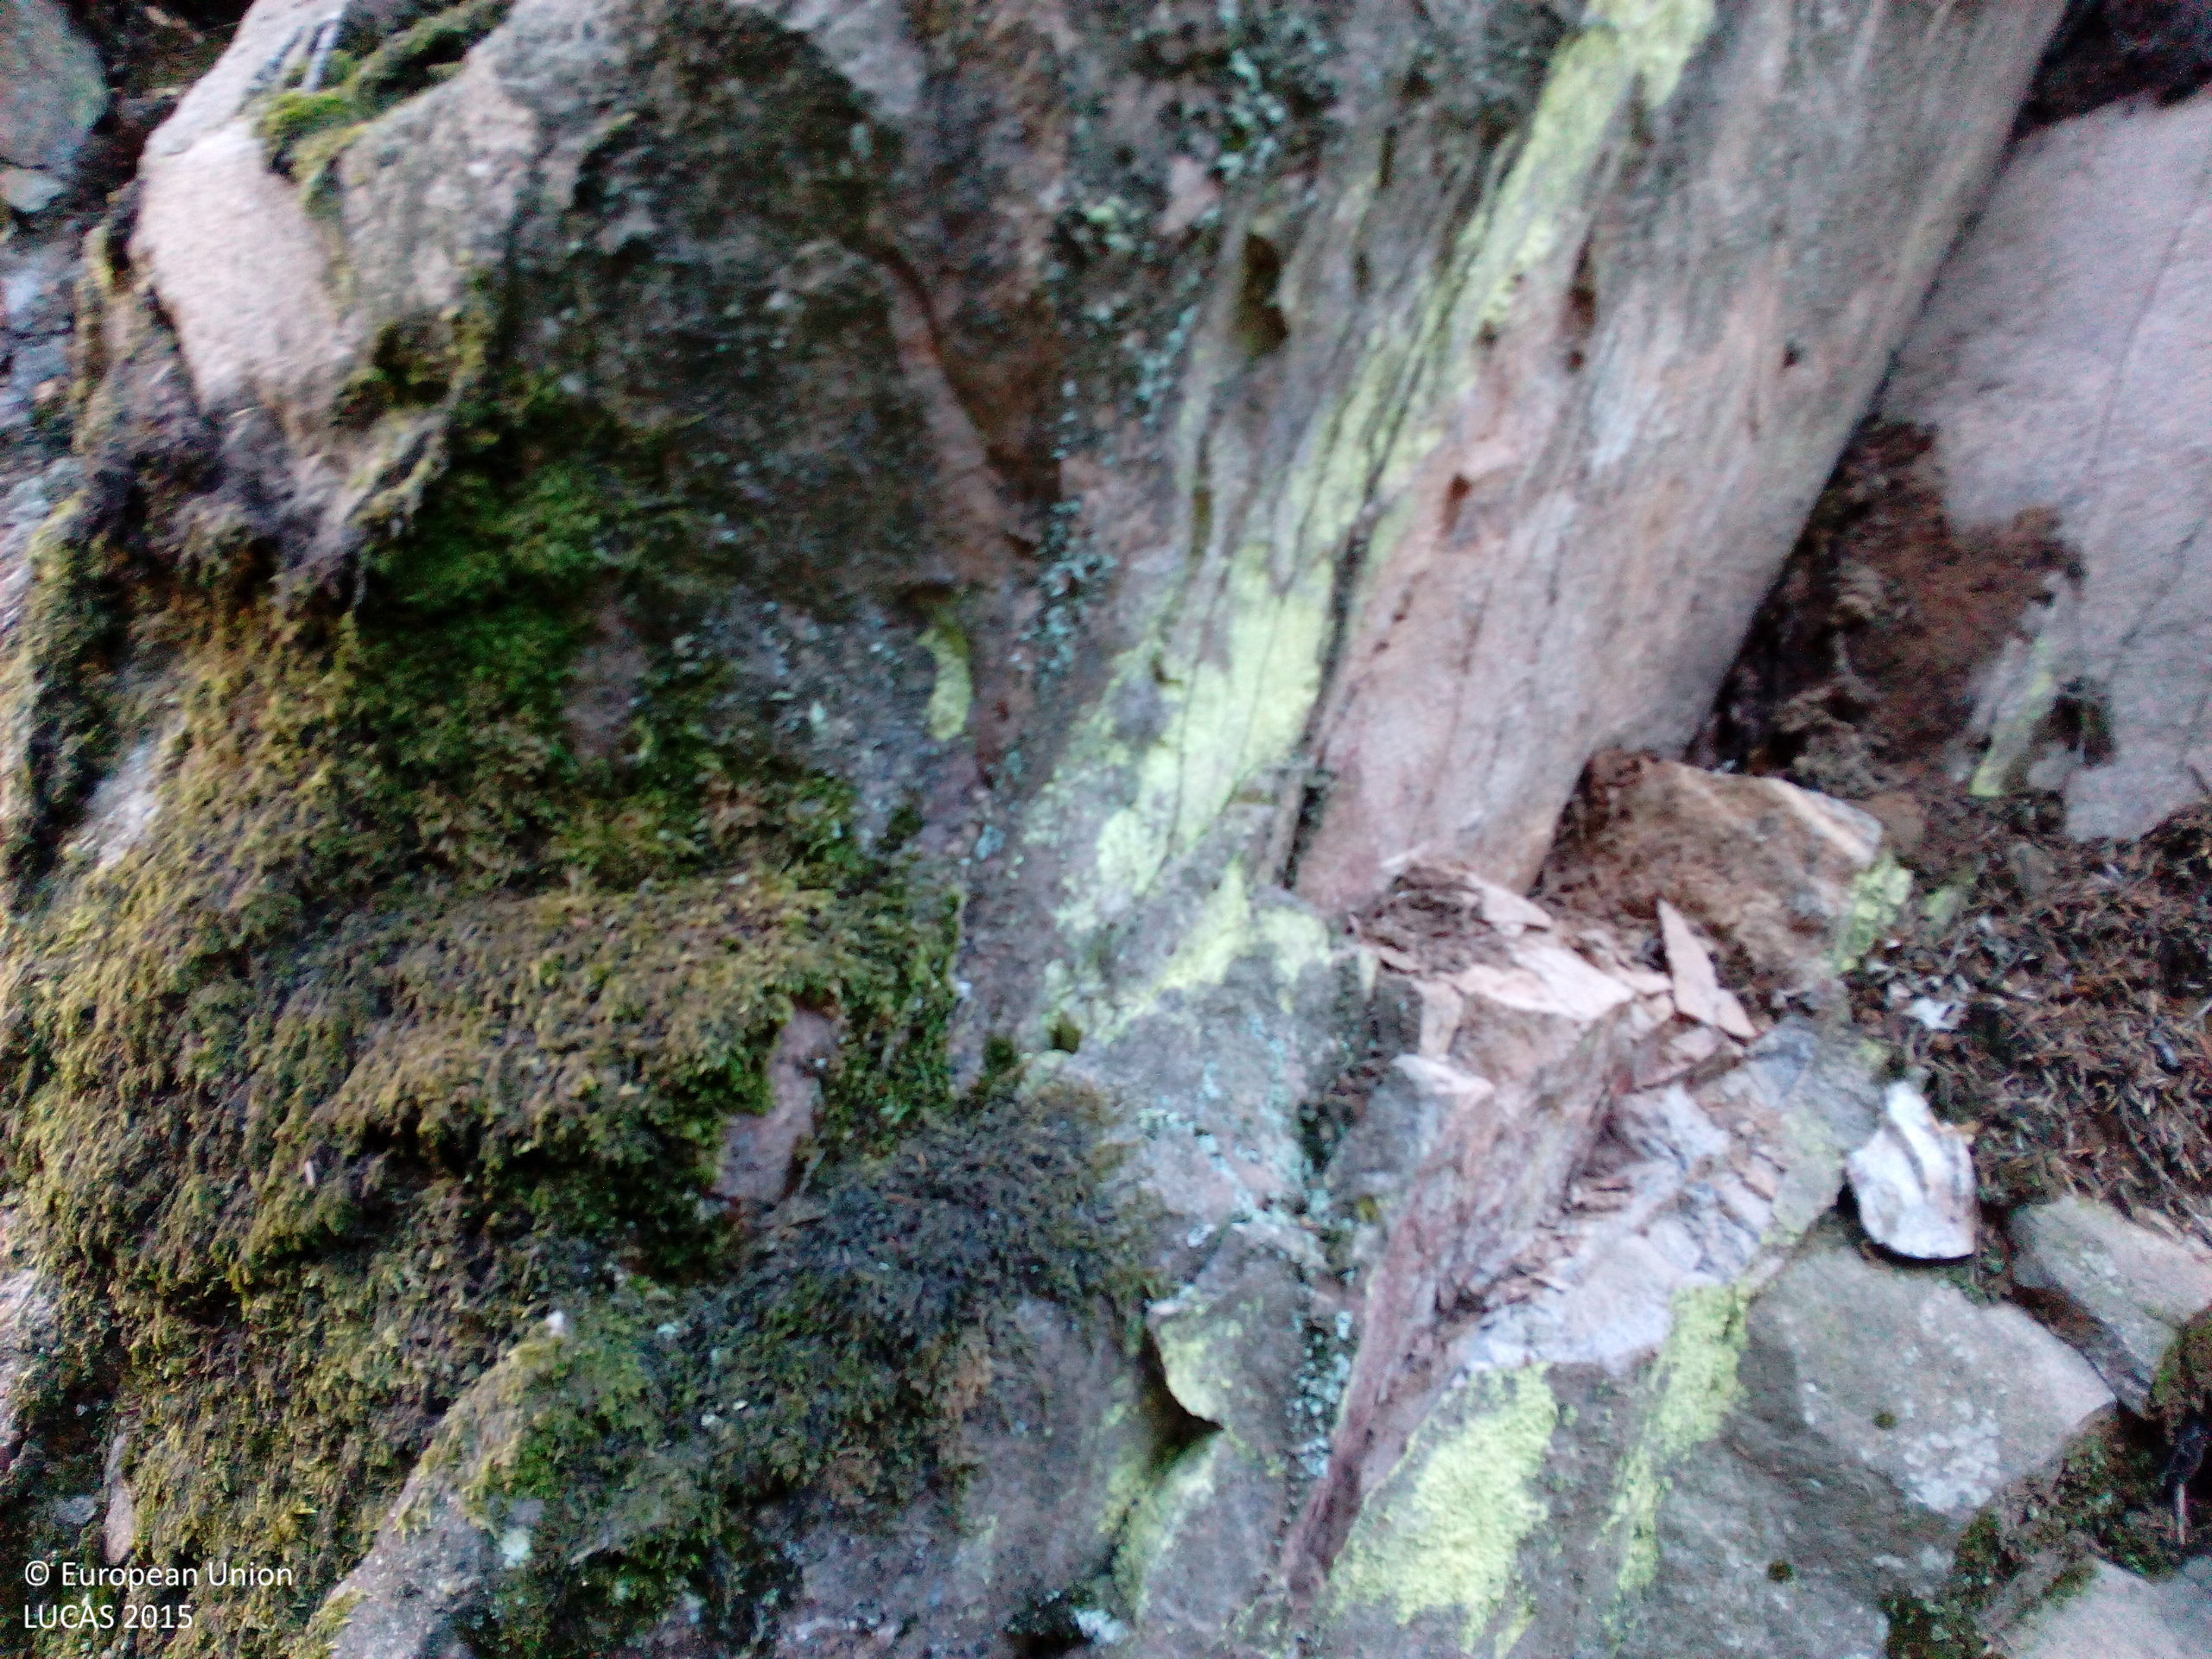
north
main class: Woodland
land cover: Other mixed woodland
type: hemiboreal forest and nemoral coniferous forest and mixed broadleaved-coniferous forest
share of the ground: 50 - 75 %
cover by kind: coniferous forest trees 50 %, broadleaved forest trees 25 %, lichens and mosses 25 %
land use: Forestry
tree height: > 5 m
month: September
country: DE
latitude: 48.2972
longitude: 8.1002
